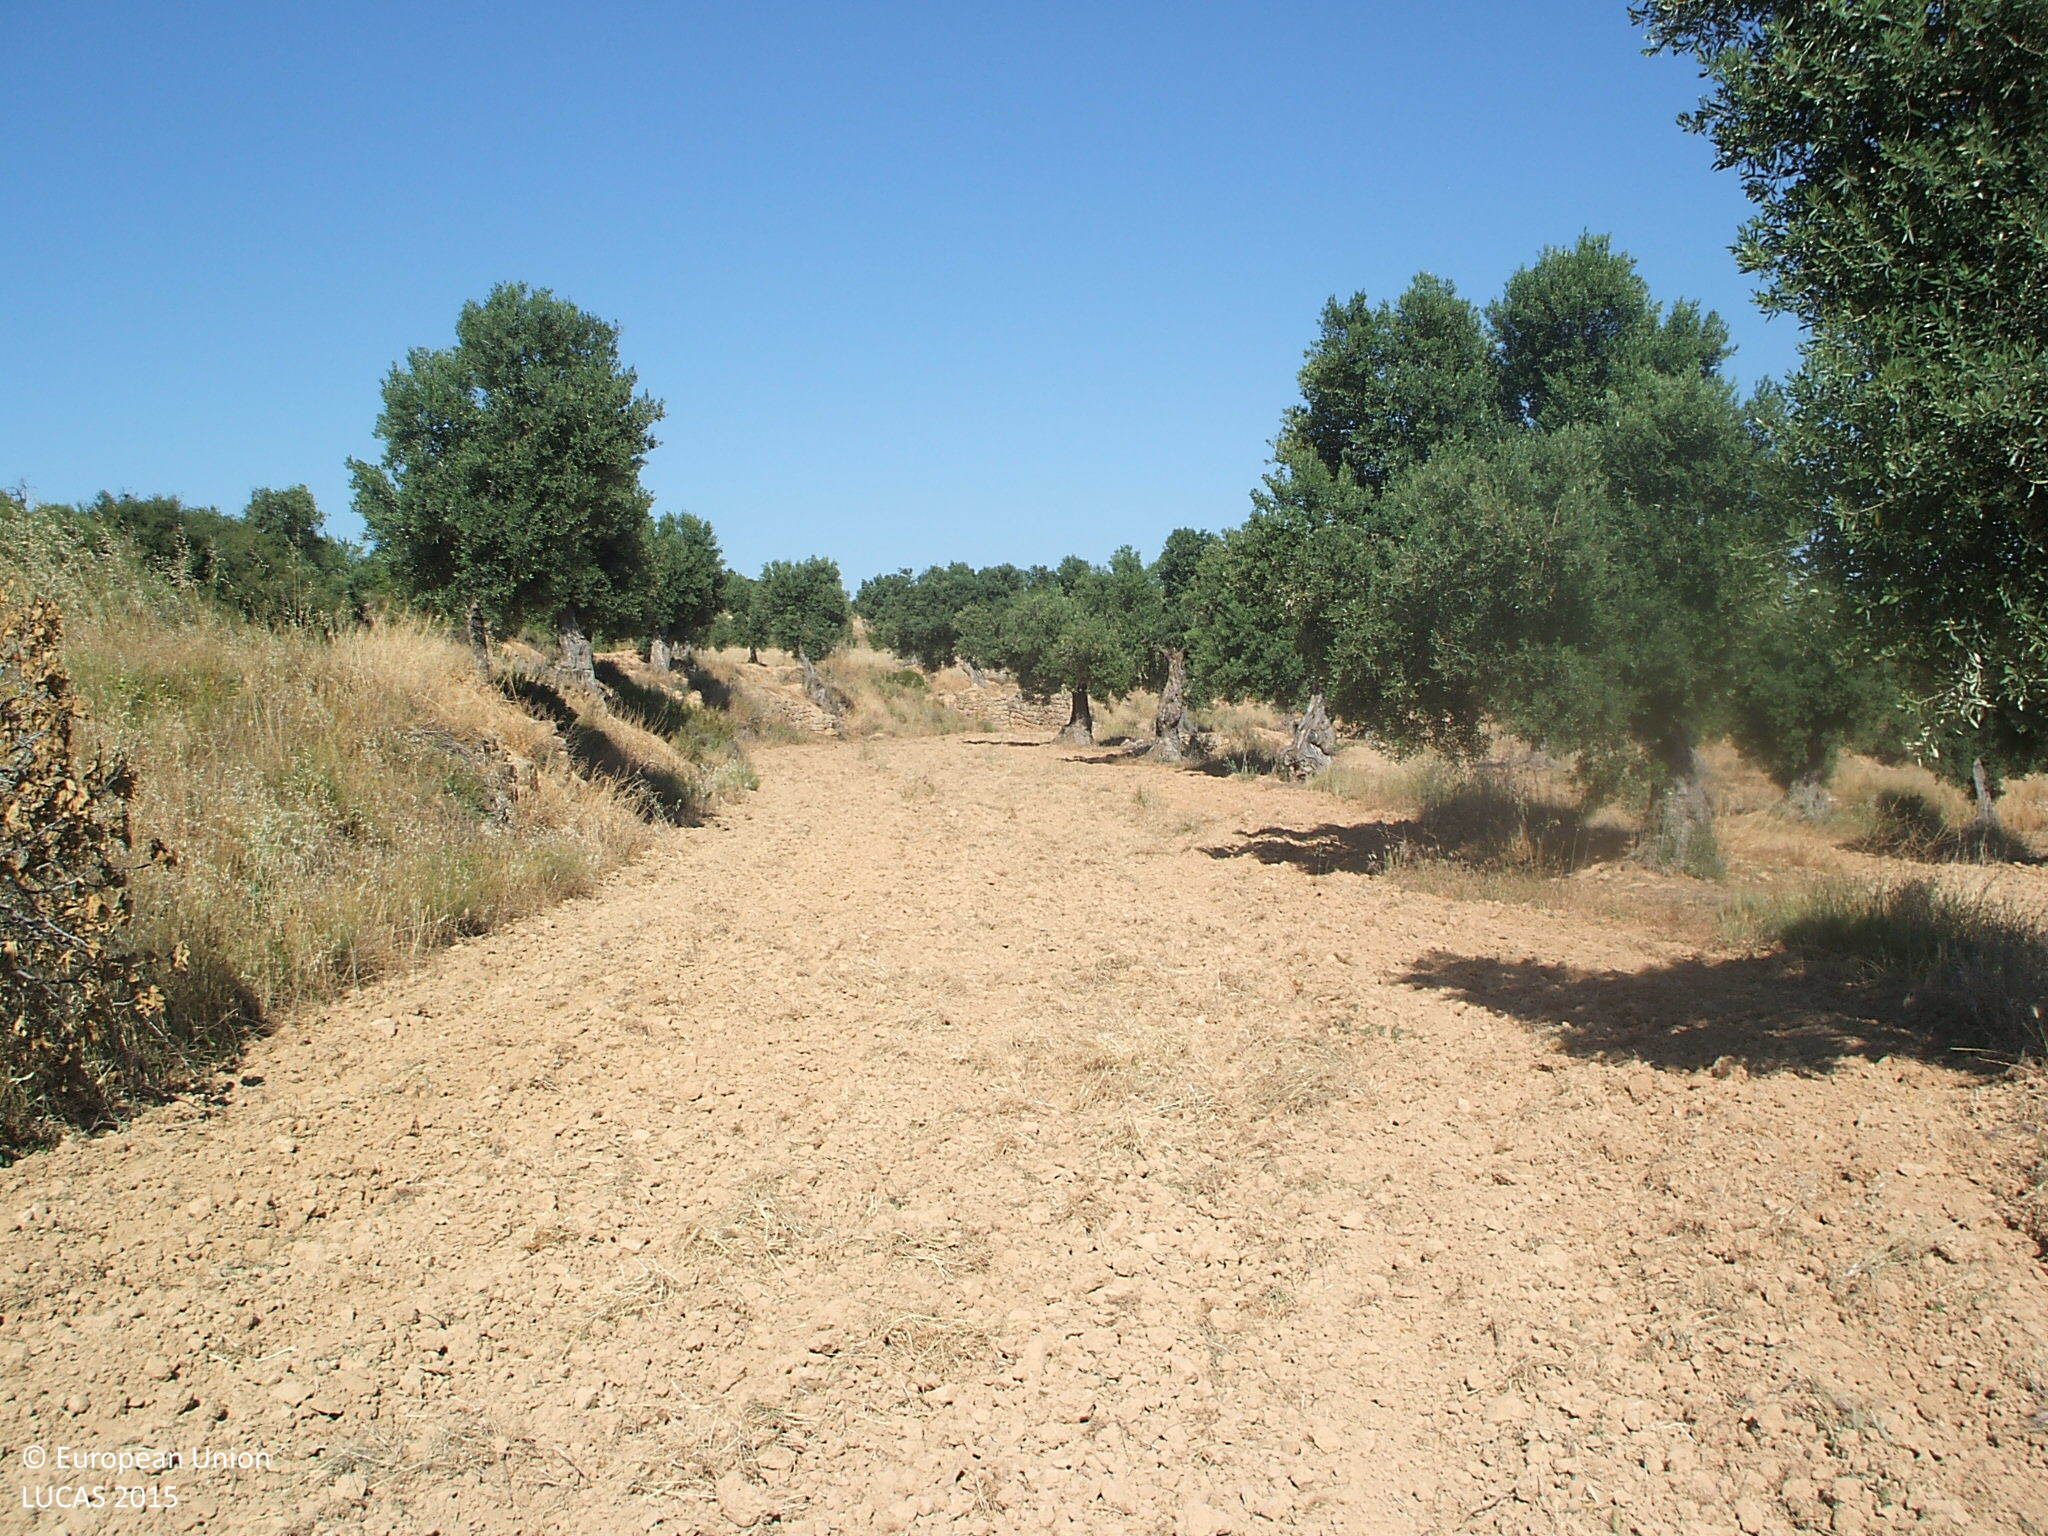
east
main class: Cropland
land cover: Olive groves
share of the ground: 10 - 25 %
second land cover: Other bare soil
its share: > 75 %
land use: Agriculture (excluding fallow land and kitchen gardens)
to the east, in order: Olive groves; Other bare soil; Olive groves; Grass margins; Dry stone walls; Grass margins; Olive groves; Grass margins; Dry stone walls; Grass margins; Olive groves; Grass margins; Olive groves; Grass margins; Dry stone walls; Olive groves; Grass margins; Nuts trees
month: June
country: ES
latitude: 41.0094
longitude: 0.1573
